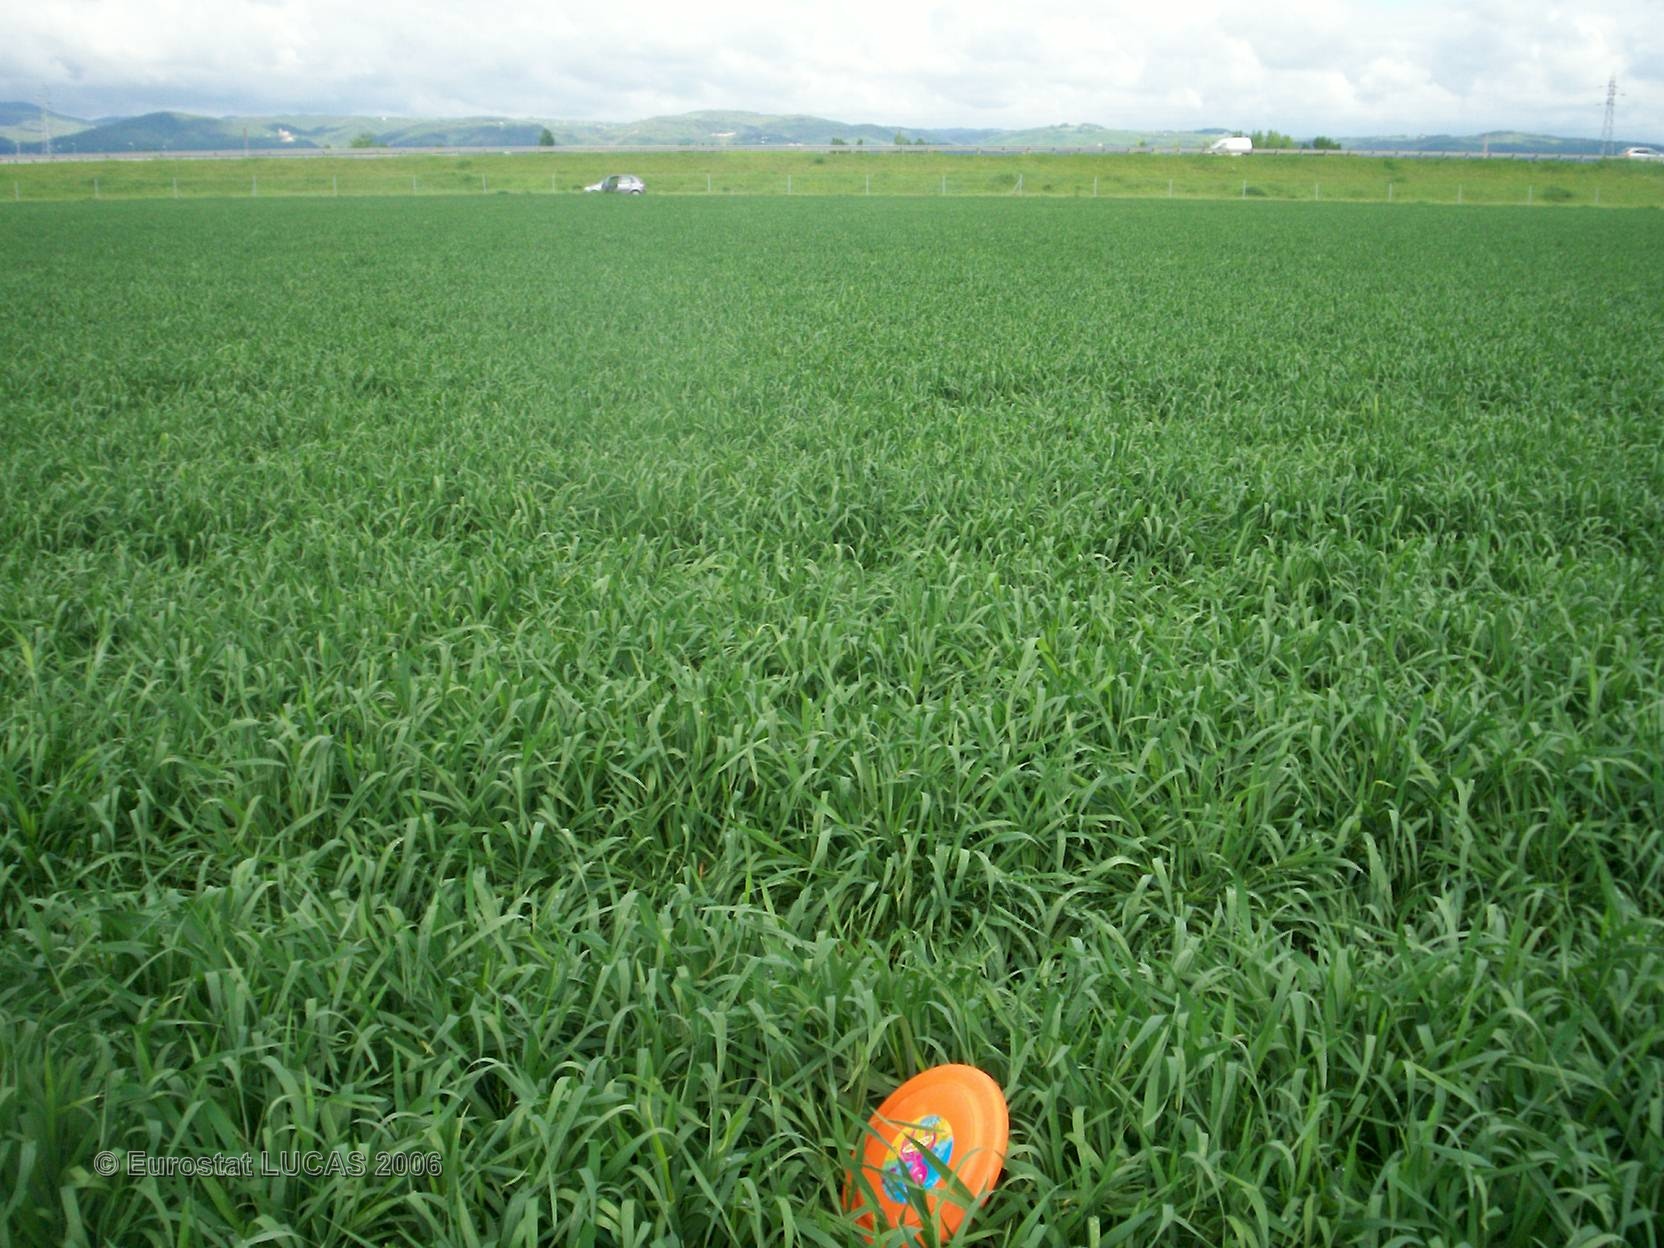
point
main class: Cropland
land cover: Barley
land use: Agriculture (excluding fallow land and kitchen gardens)
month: May
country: FR
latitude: 45.8969
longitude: 3.1557
